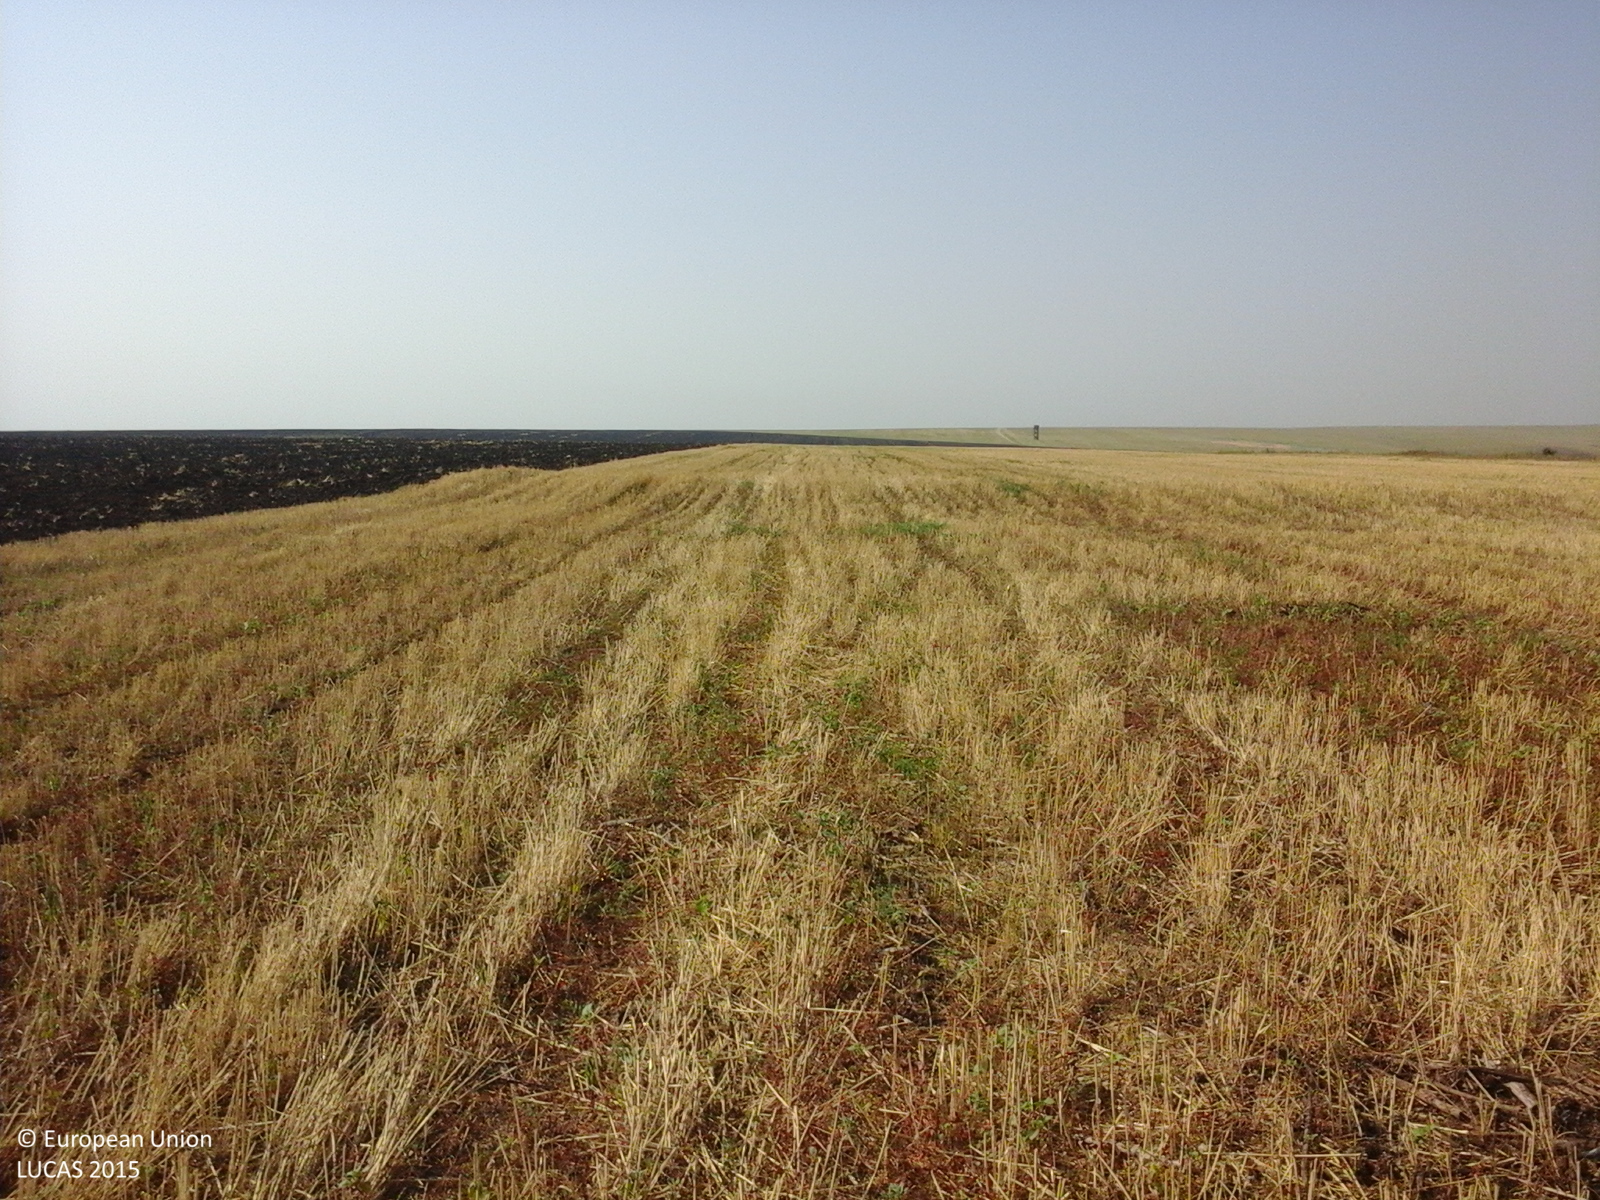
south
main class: Cropland
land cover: Common wheat
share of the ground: > 75 %
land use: Agriculture (excluding fallow land and kitchen gardens)
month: July
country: RO
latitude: 45.6653
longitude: 27.9457
